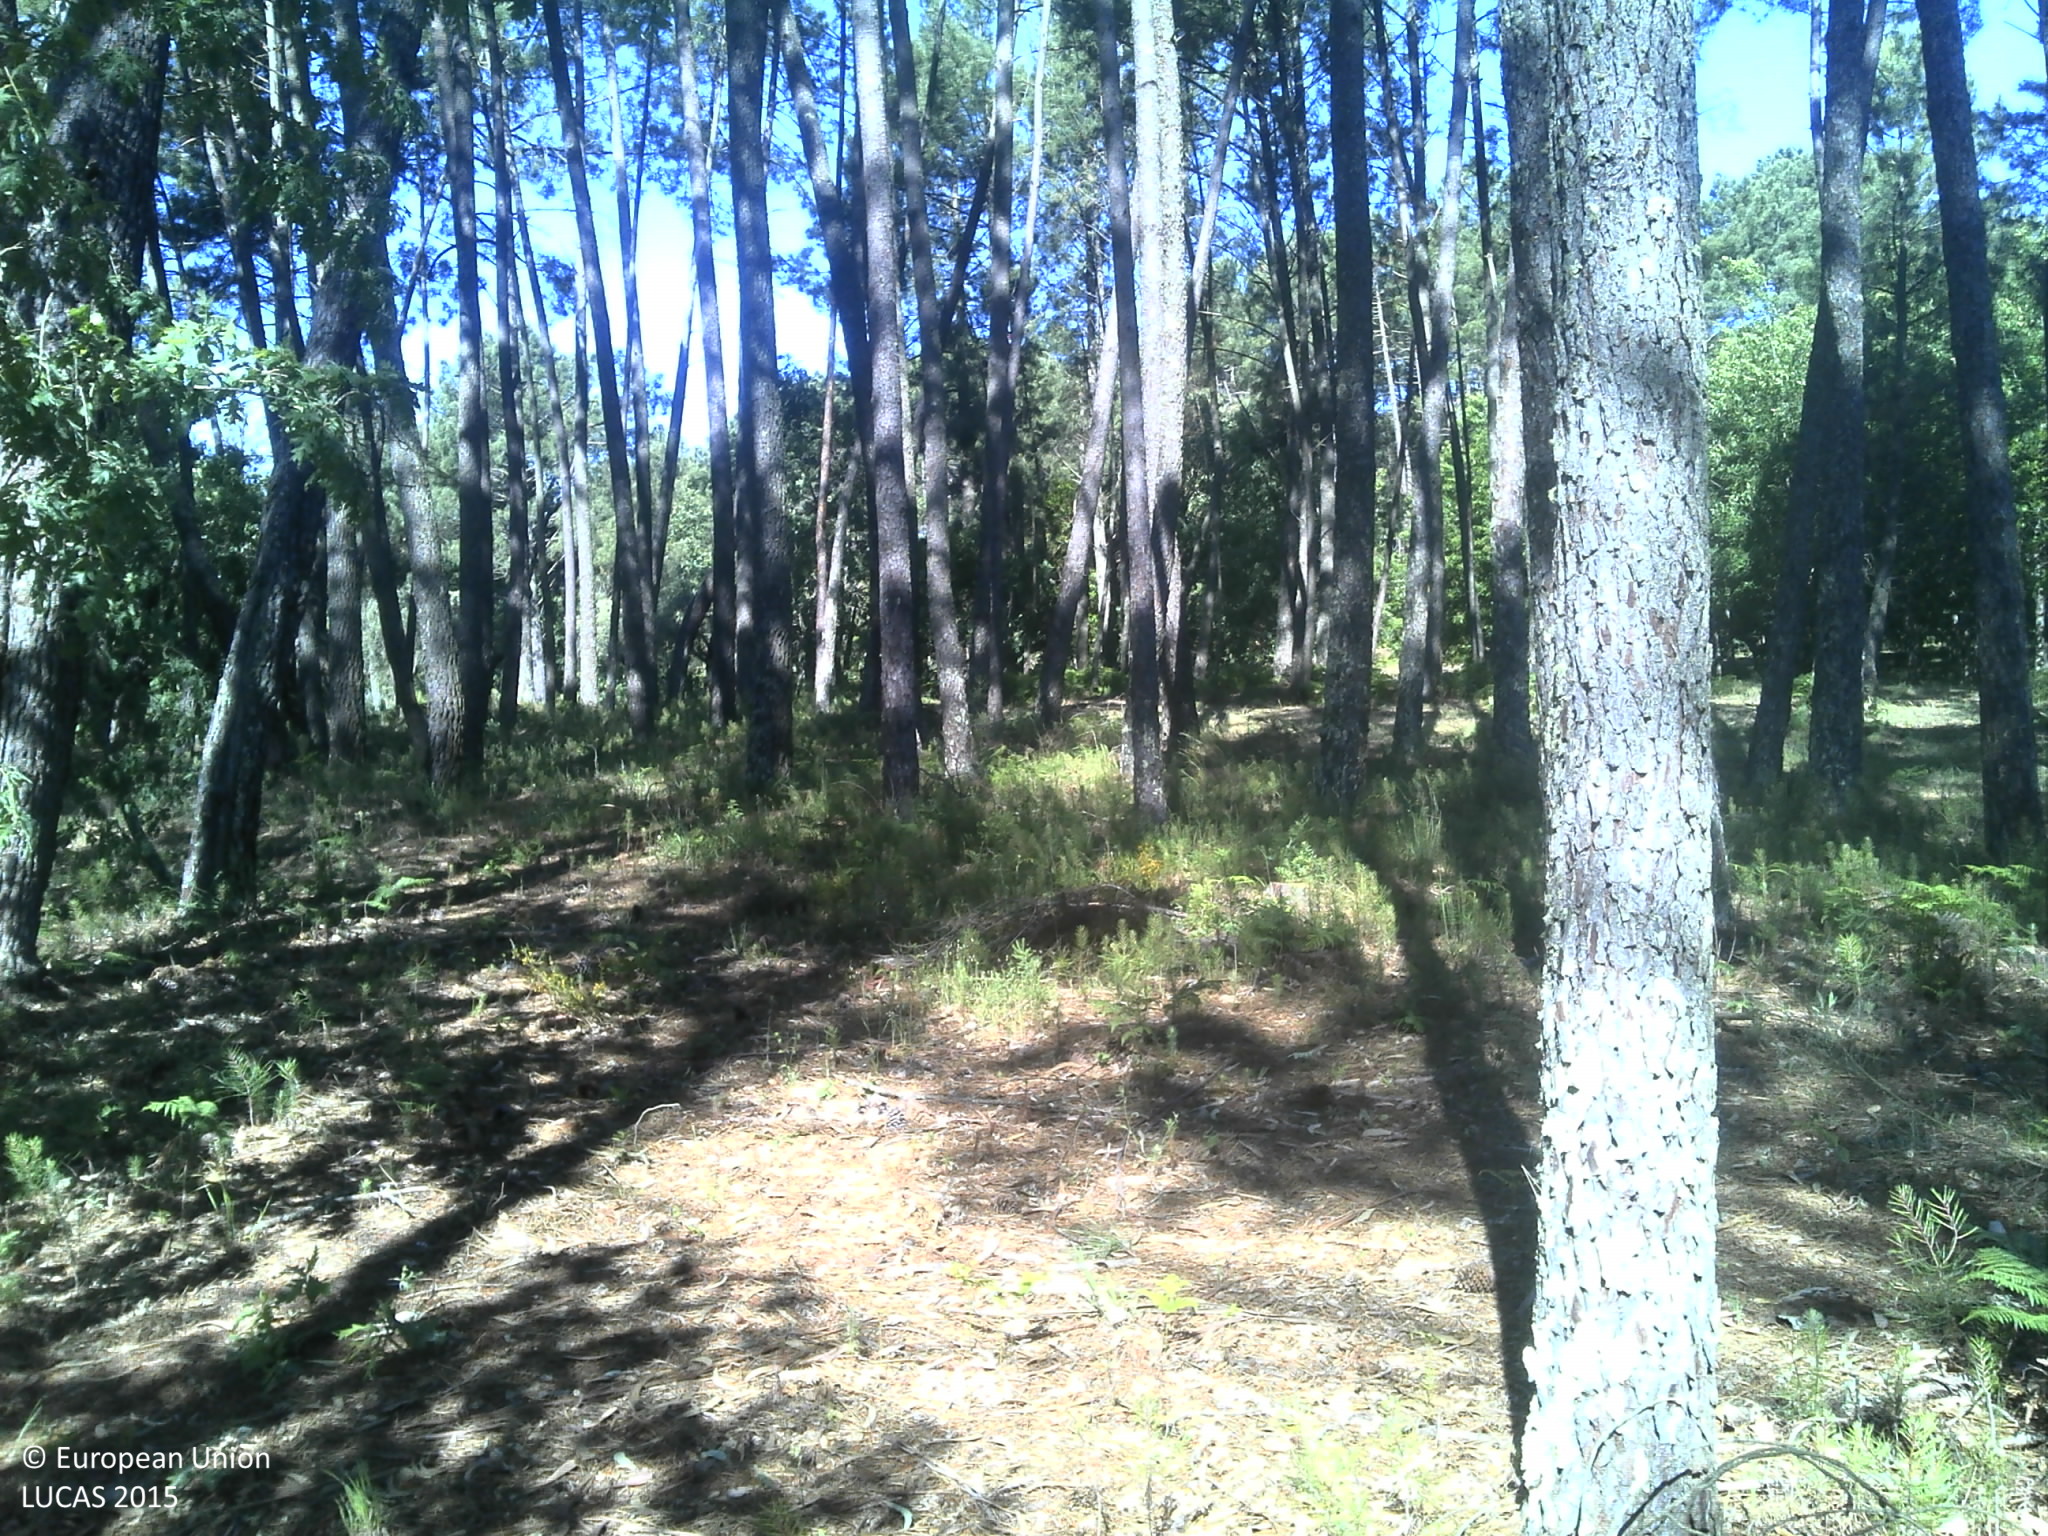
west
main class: Woodland
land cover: Pine dominated coniferous woodland
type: coniferous forest of the mediterranean region
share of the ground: 50 - 75 %
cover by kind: coniferous forest trees 70 %, shrubs 20 %, unconsolidated bare surface 10 %
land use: Forestry
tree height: > 5 m
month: May
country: PT
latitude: 40.4628
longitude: -7.7476
